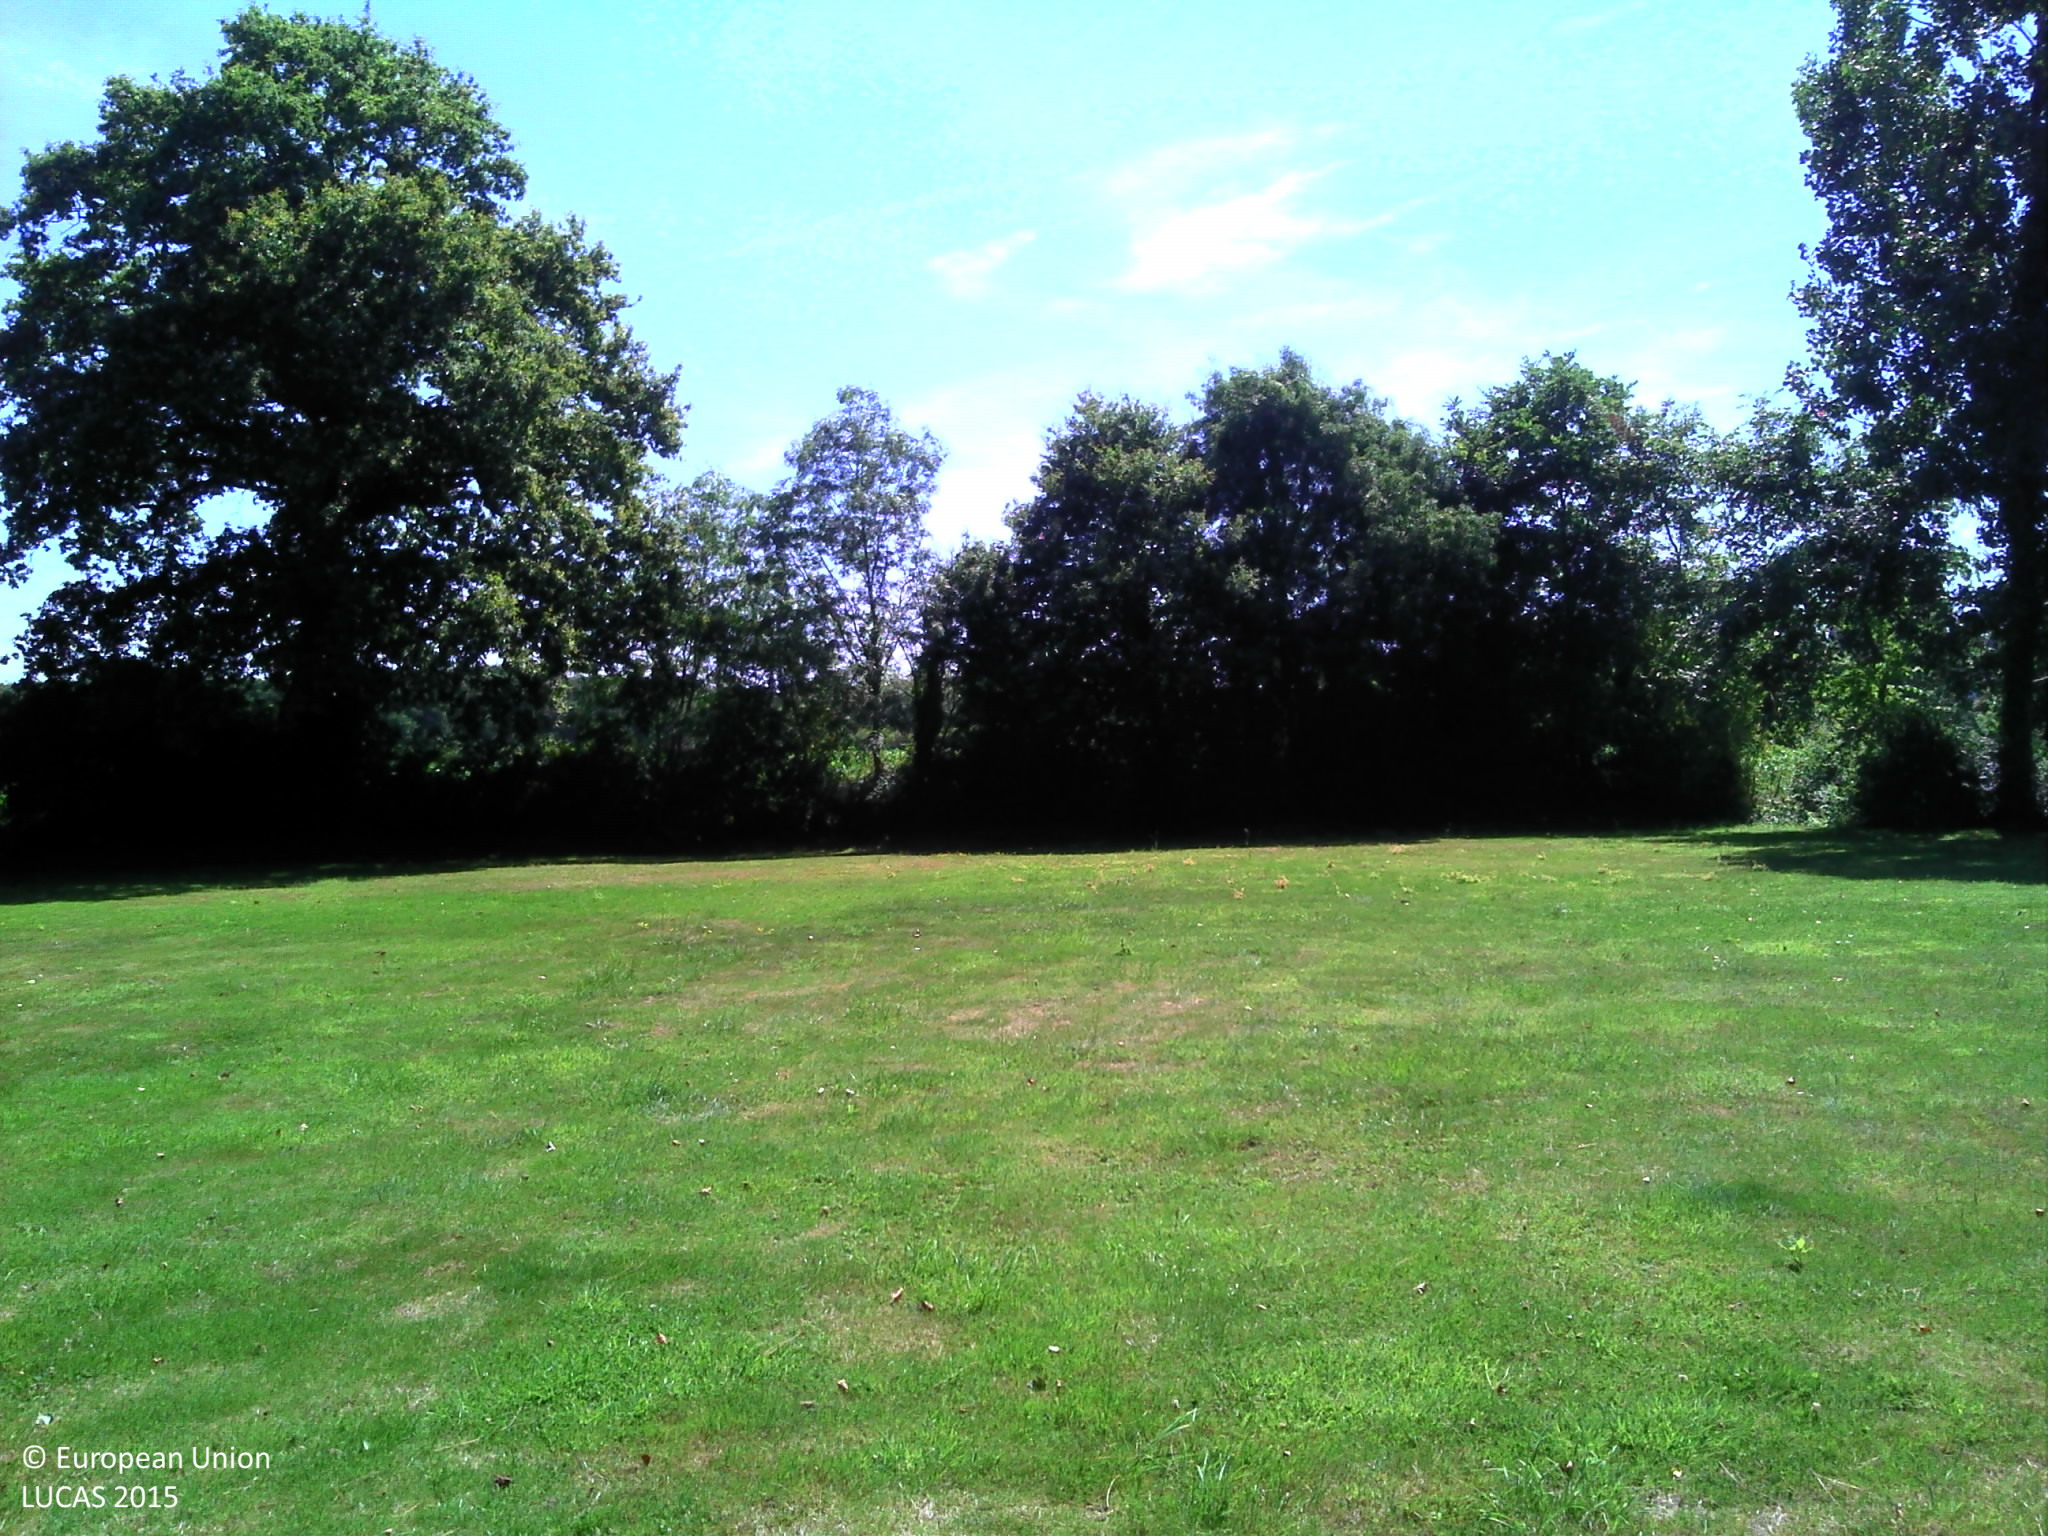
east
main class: Grassland
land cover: Grassland without tree/shrub cover
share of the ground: > 75 %
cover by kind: herbaceous plants 100 %
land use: Residential
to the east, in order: Grassland without tree/shrub cover; Managed hedges; Maize; Tracks; Grass margins; Ditches and canals; Shrubland with sparse tree cover; Grass margins; Common wheat
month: June
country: FR
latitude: 46.8936
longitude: -1.6576
